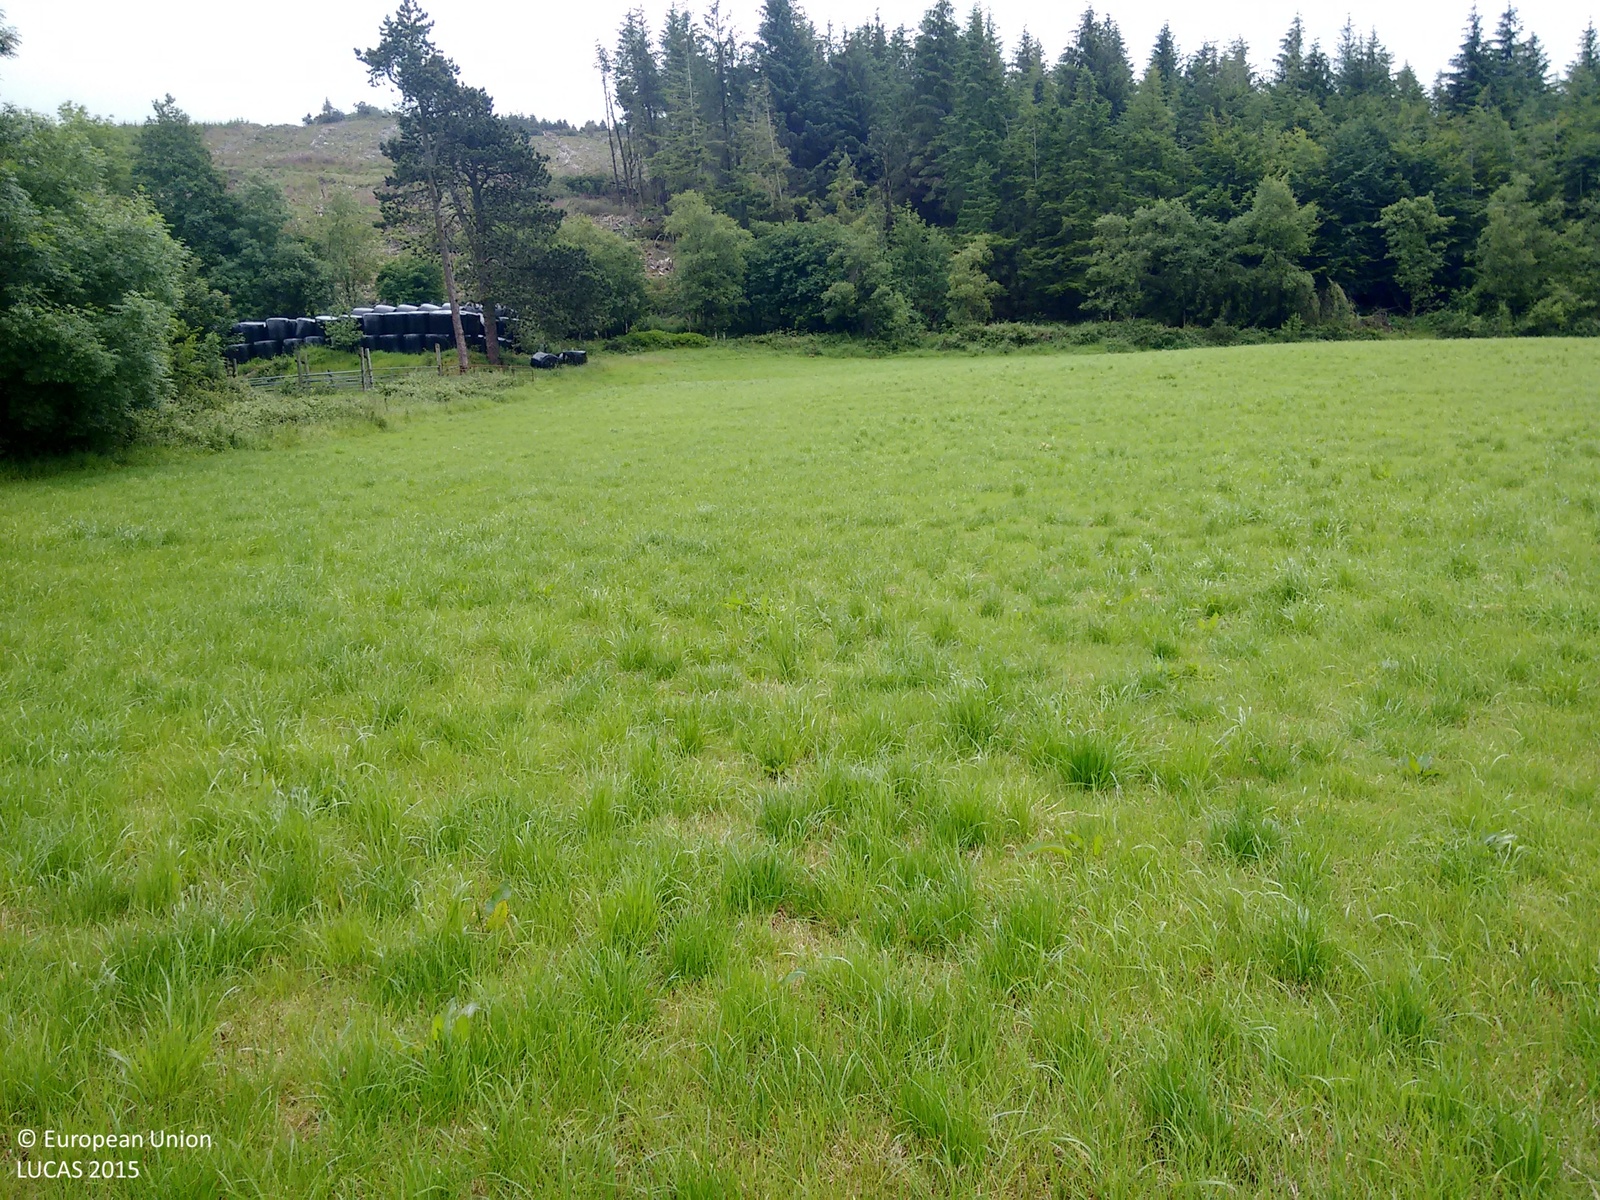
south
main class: Grassland
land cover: Grassland without tree/shrub cover
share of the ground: > 75 %
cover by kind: herbaceous plants 100 %
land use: Agriculture (excluding fallow land and kitchen gardens)
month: July
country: IE
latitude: 52.3328
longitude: -8.4632
